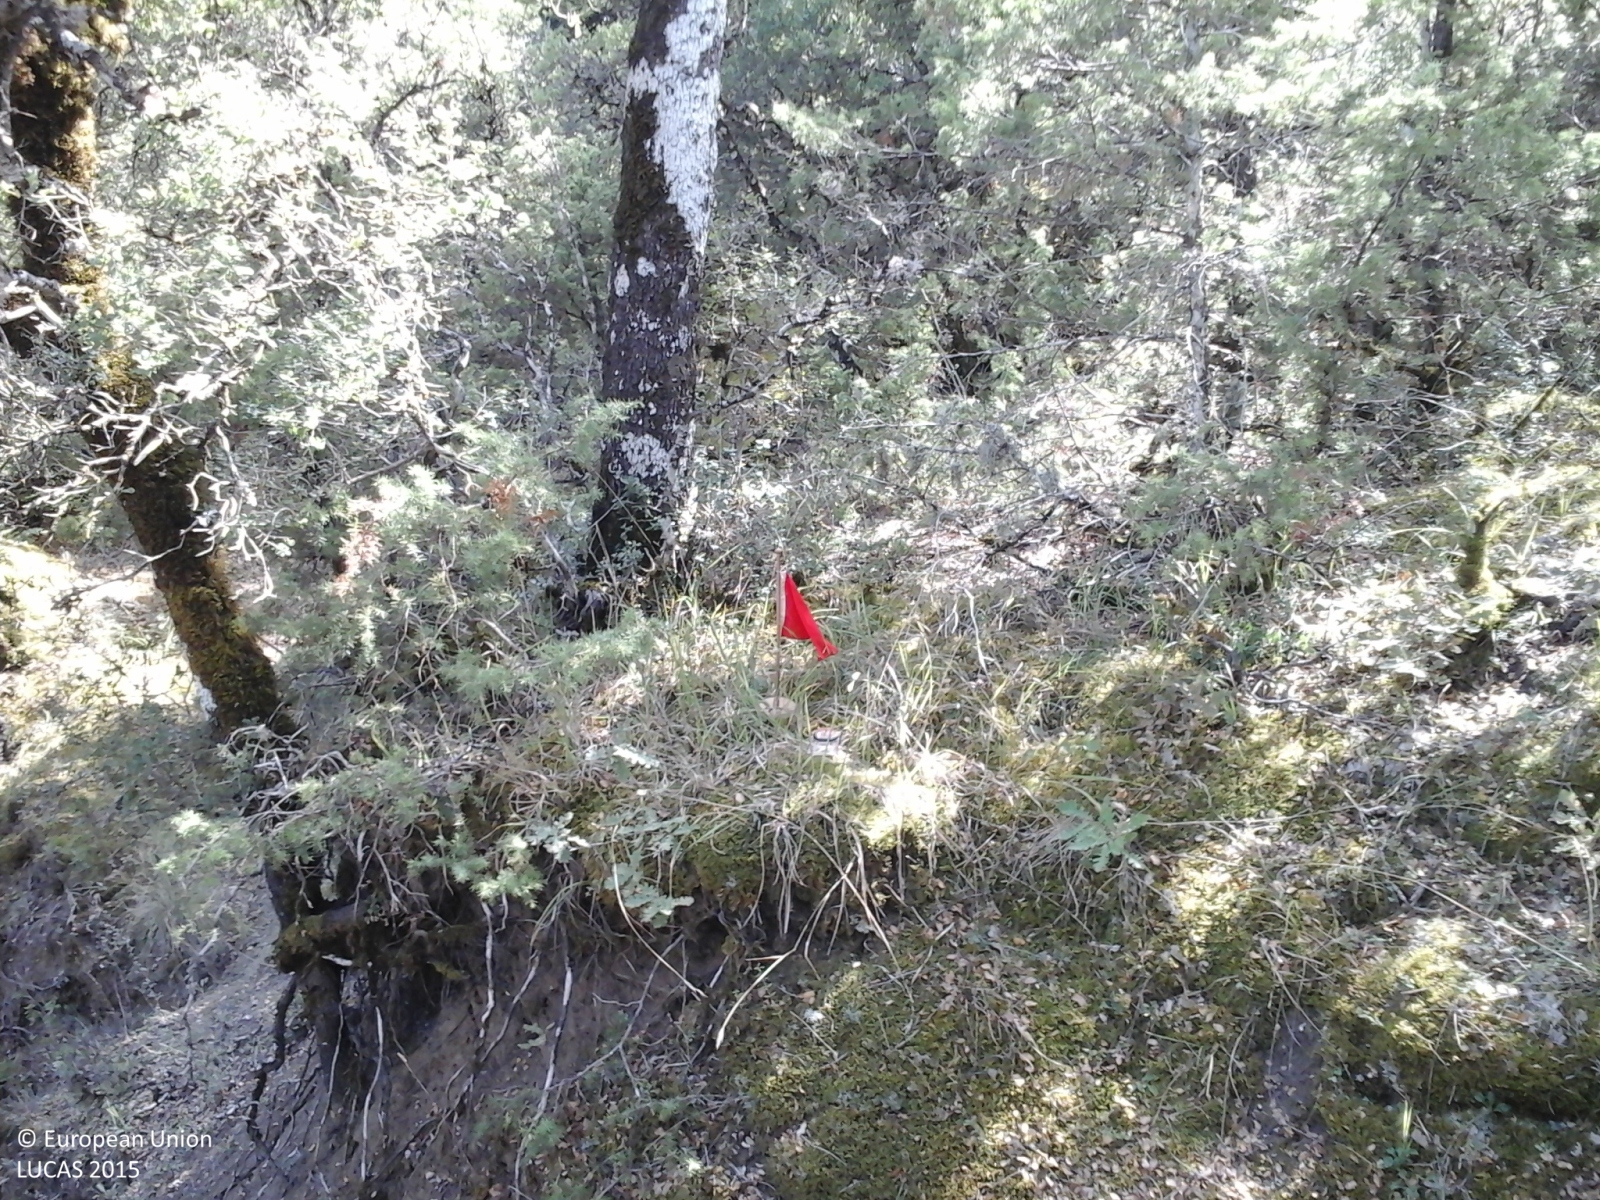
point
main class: Woodland
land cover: Broadleaved woodland
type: broadleaved evergreen forest
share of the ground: > 75 %
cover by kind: broadleaved forest trees 80 %, shrubs 10 %, herbaceous plants 5 %, unconsolidated bare surface 5 %
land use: Forestry
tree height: > 5 m
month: September
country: GR
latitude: 39.7399
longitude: 20.9840
